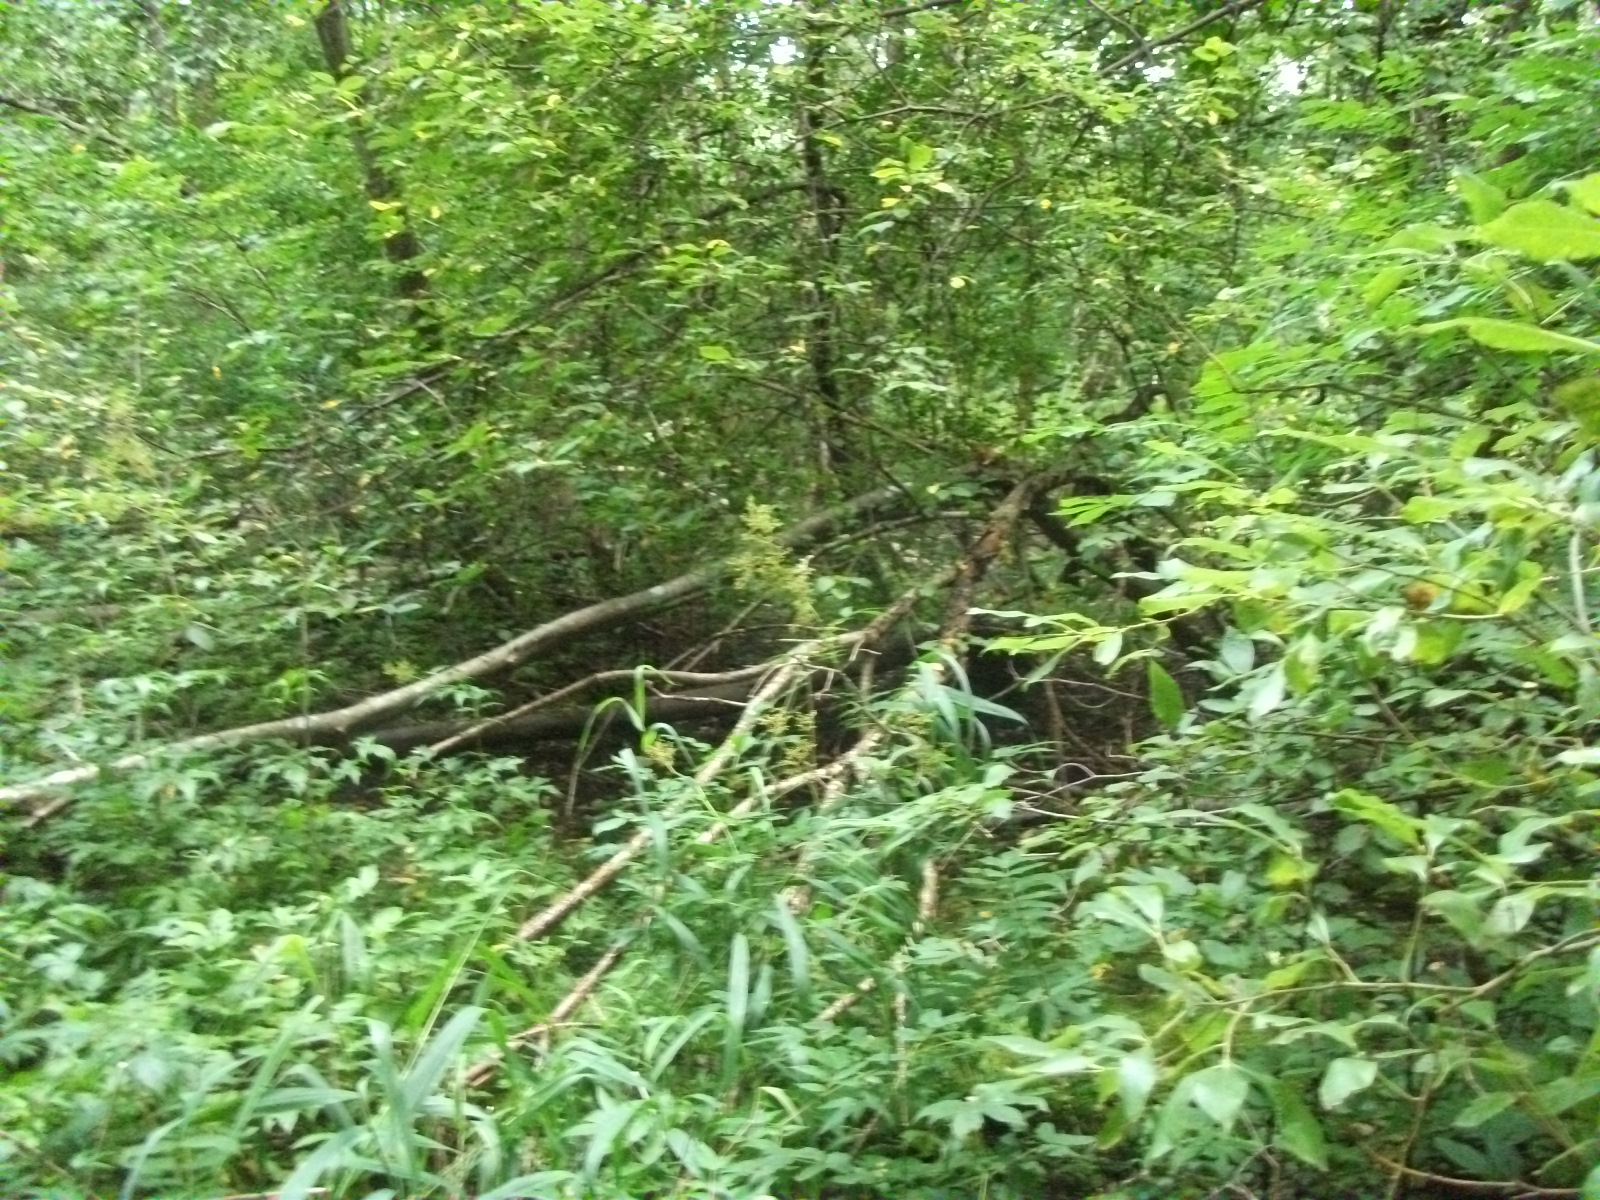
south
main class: Woodland
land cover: Broadleaved woodland
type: non-riverine alder, birch or aspen forest
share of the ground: > 75 %
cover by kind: broadleaved forest trees 85 %, shrubs 10 %, herbaceous plants 5 %
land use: Forestry
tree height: > 5 m
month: August
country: LV
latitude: 56.7579
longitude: 26.5538
